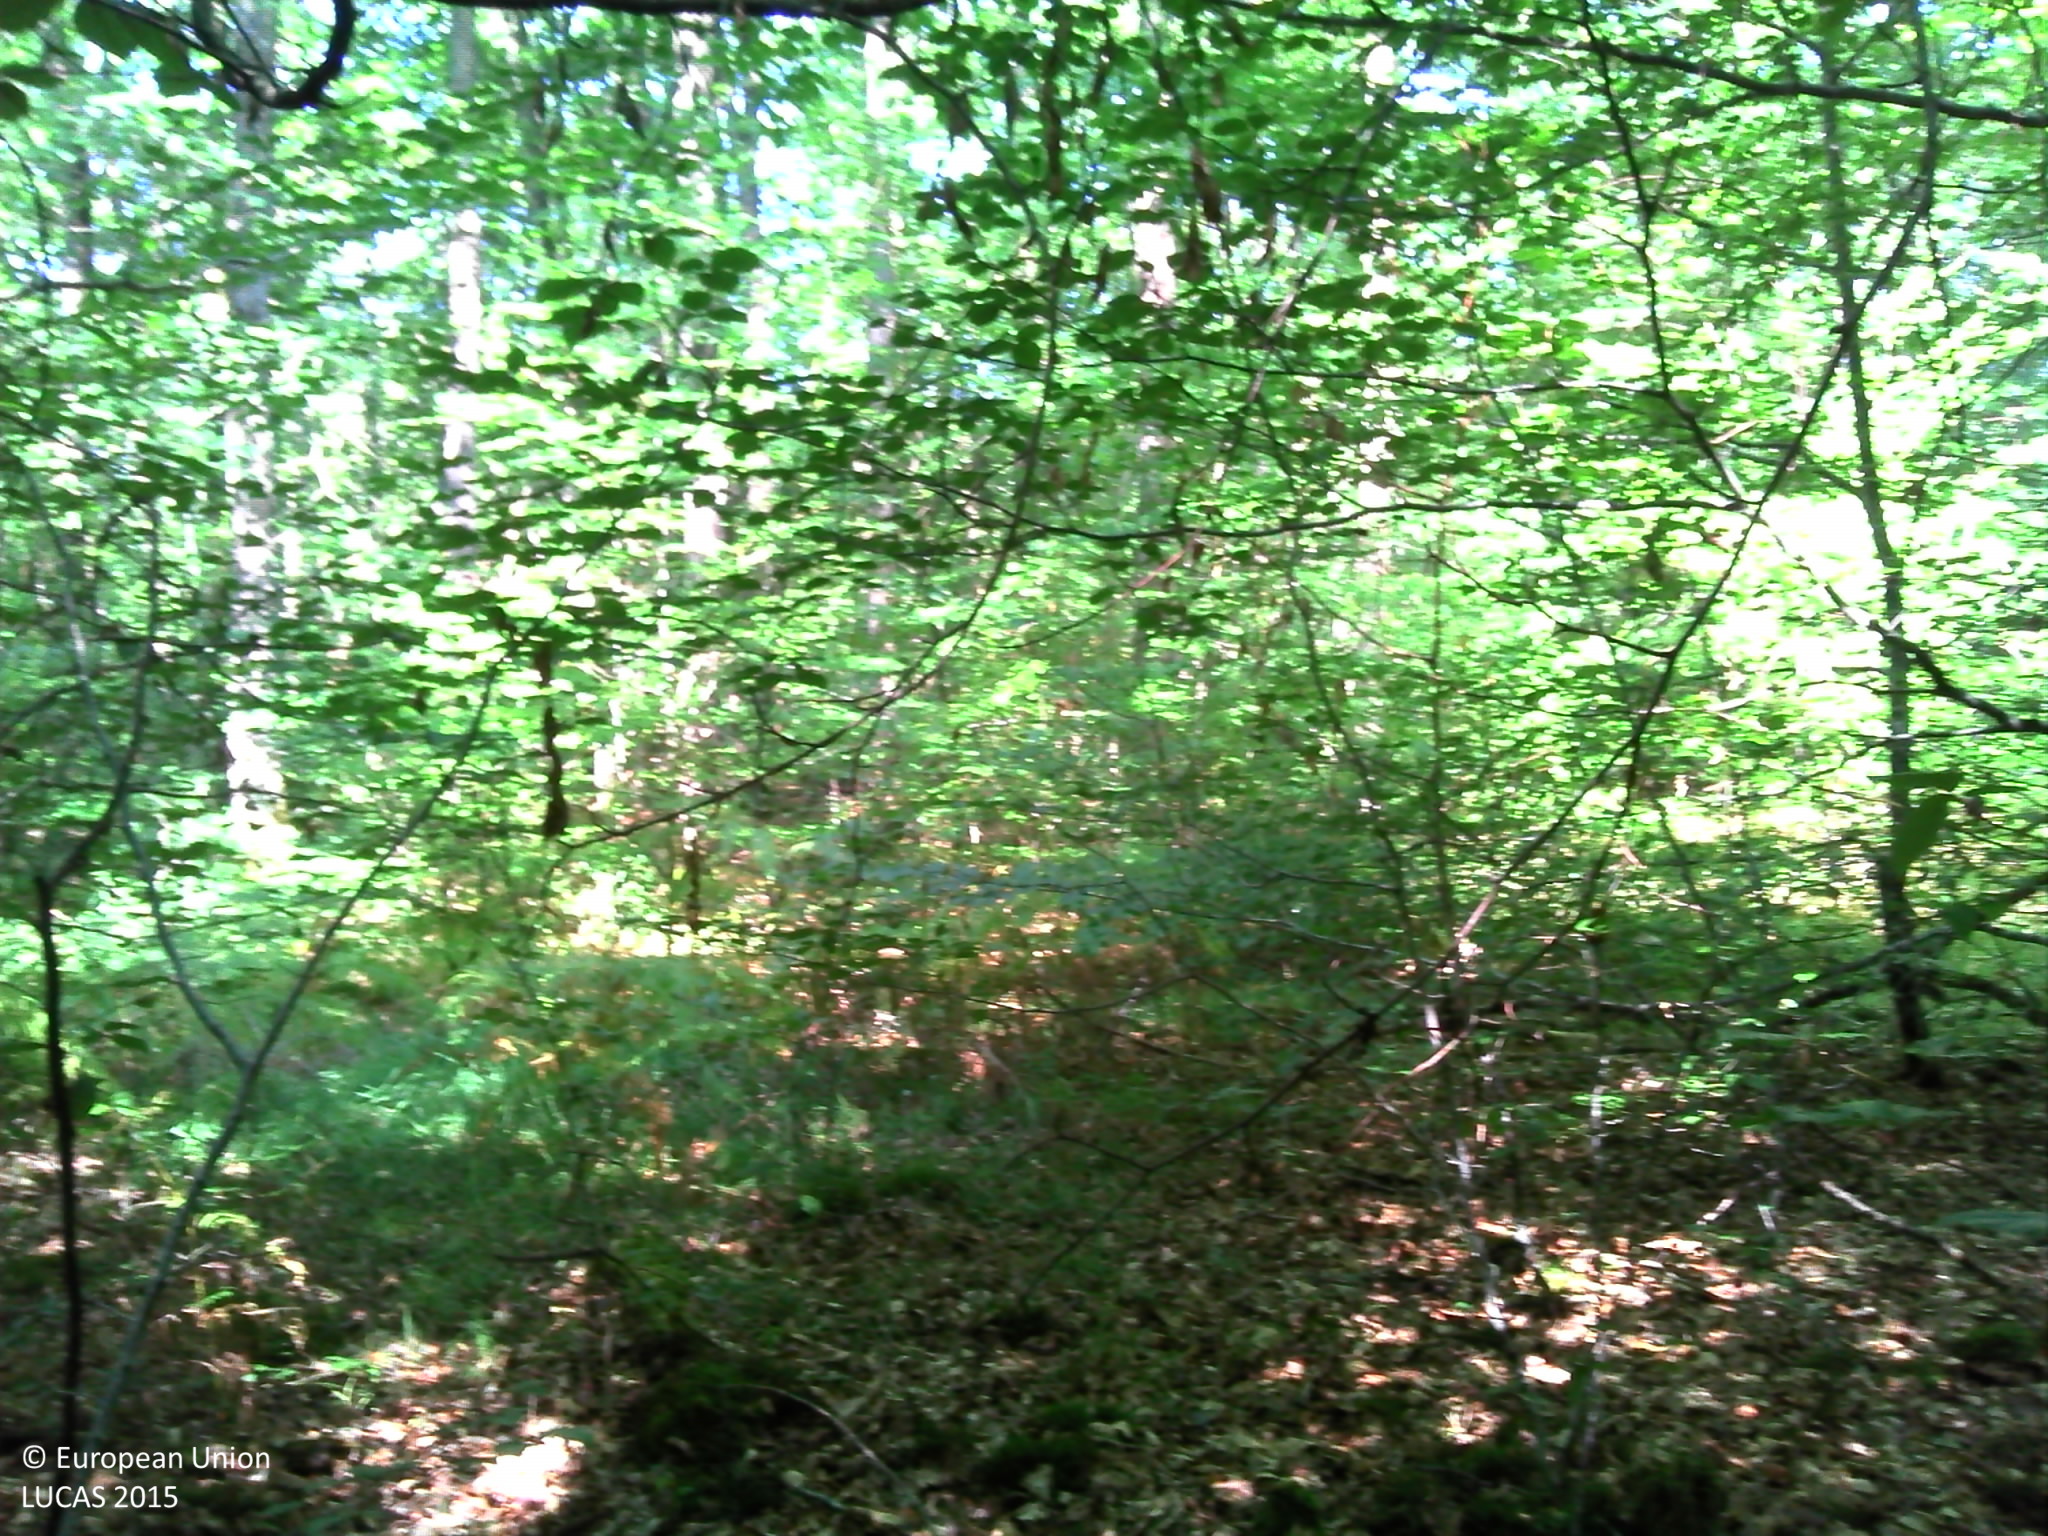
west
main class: Woodland
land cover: Broadleaved woodland
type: beech forest
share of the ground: > 75 %
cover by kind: broadleaved forest trees 90 %, herbaceous plants 5 %, lichens and mosses 5 %
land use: Forestry
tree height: > 5 m
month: August
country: FR
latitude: 46.6470
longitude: 2.7443
